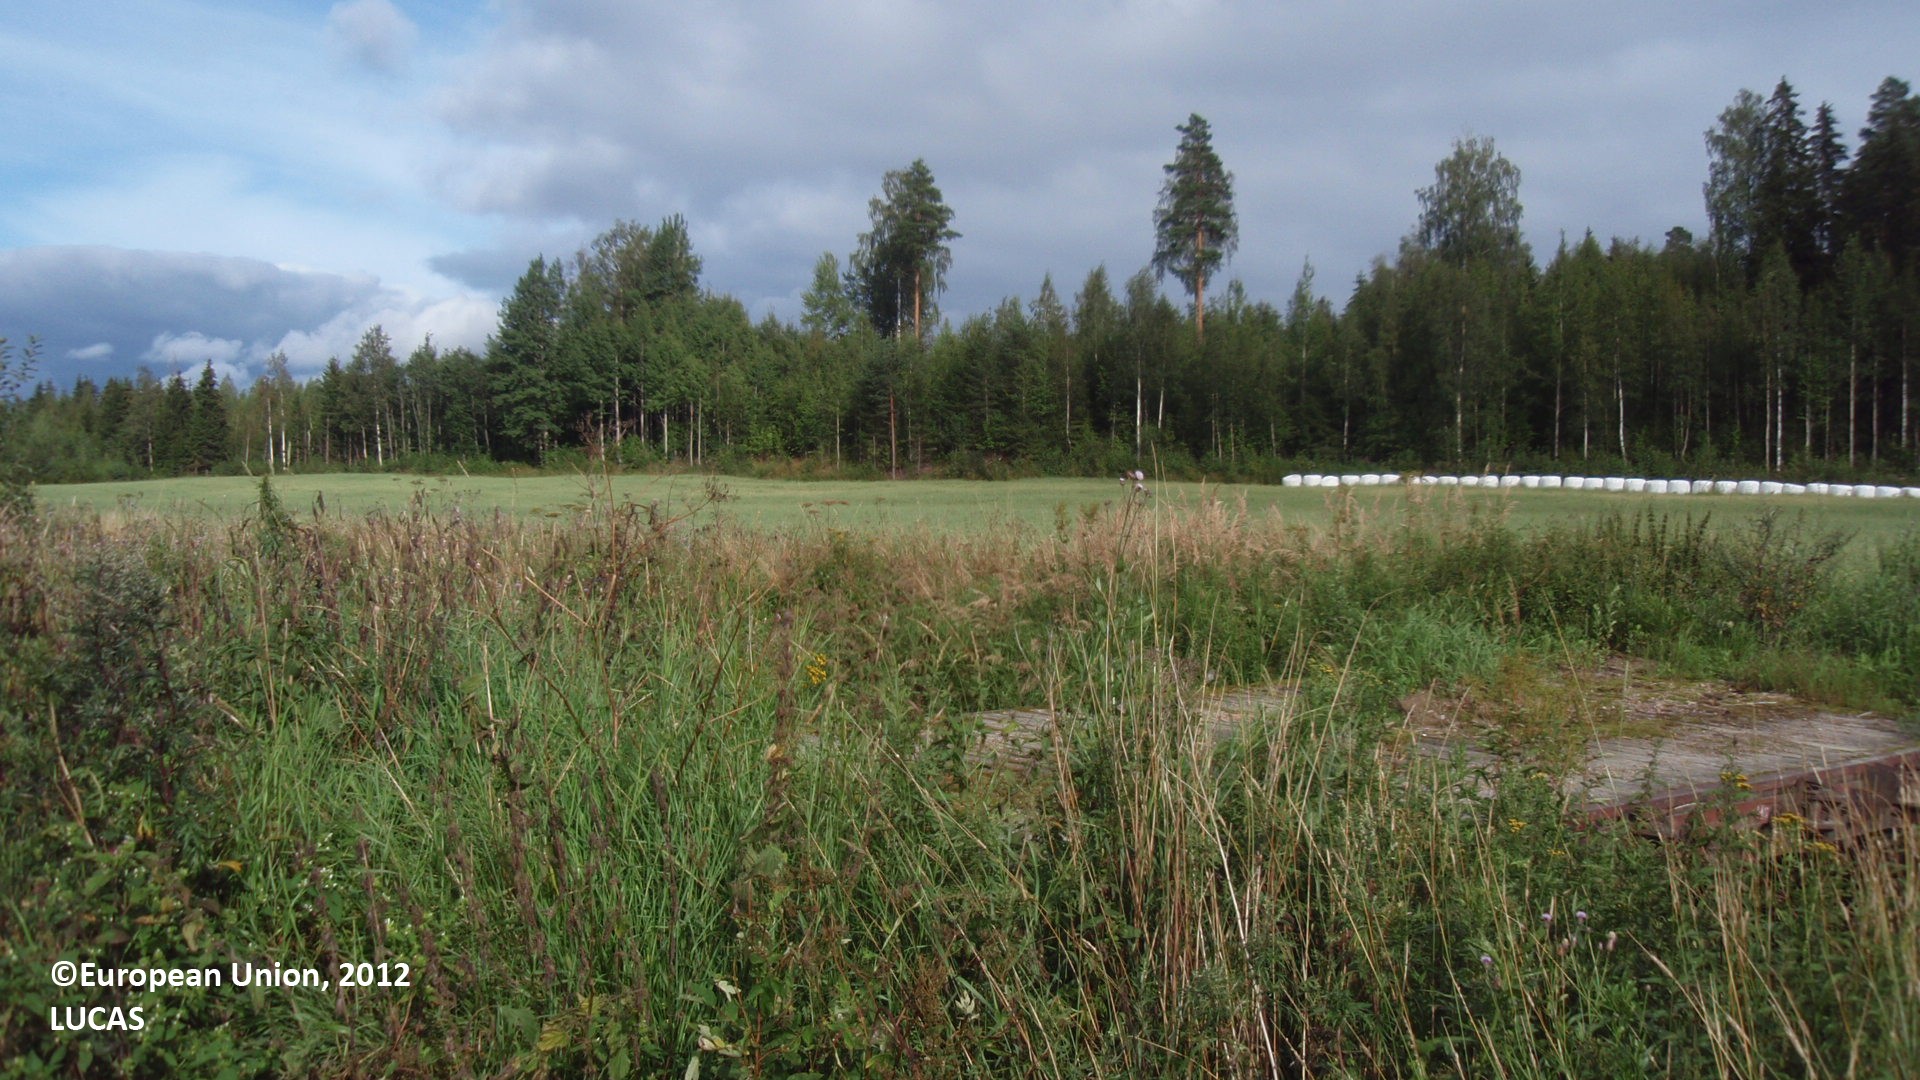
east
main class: Cropland
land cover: Rape and turnip rape
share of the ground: > 75 %
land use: Agriculture (excluding fallow land and kitchen gardens)
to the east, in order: Rape and turnip rape; Ditches and canals; Oats; Ditches and canals; Oats; Grass margins; Ditches and canals; Grass margins; Broadleaved woodland; Grassland with sparse tree/shrub cover
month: August
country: FI
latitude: 60.9110
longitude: 27.6119
